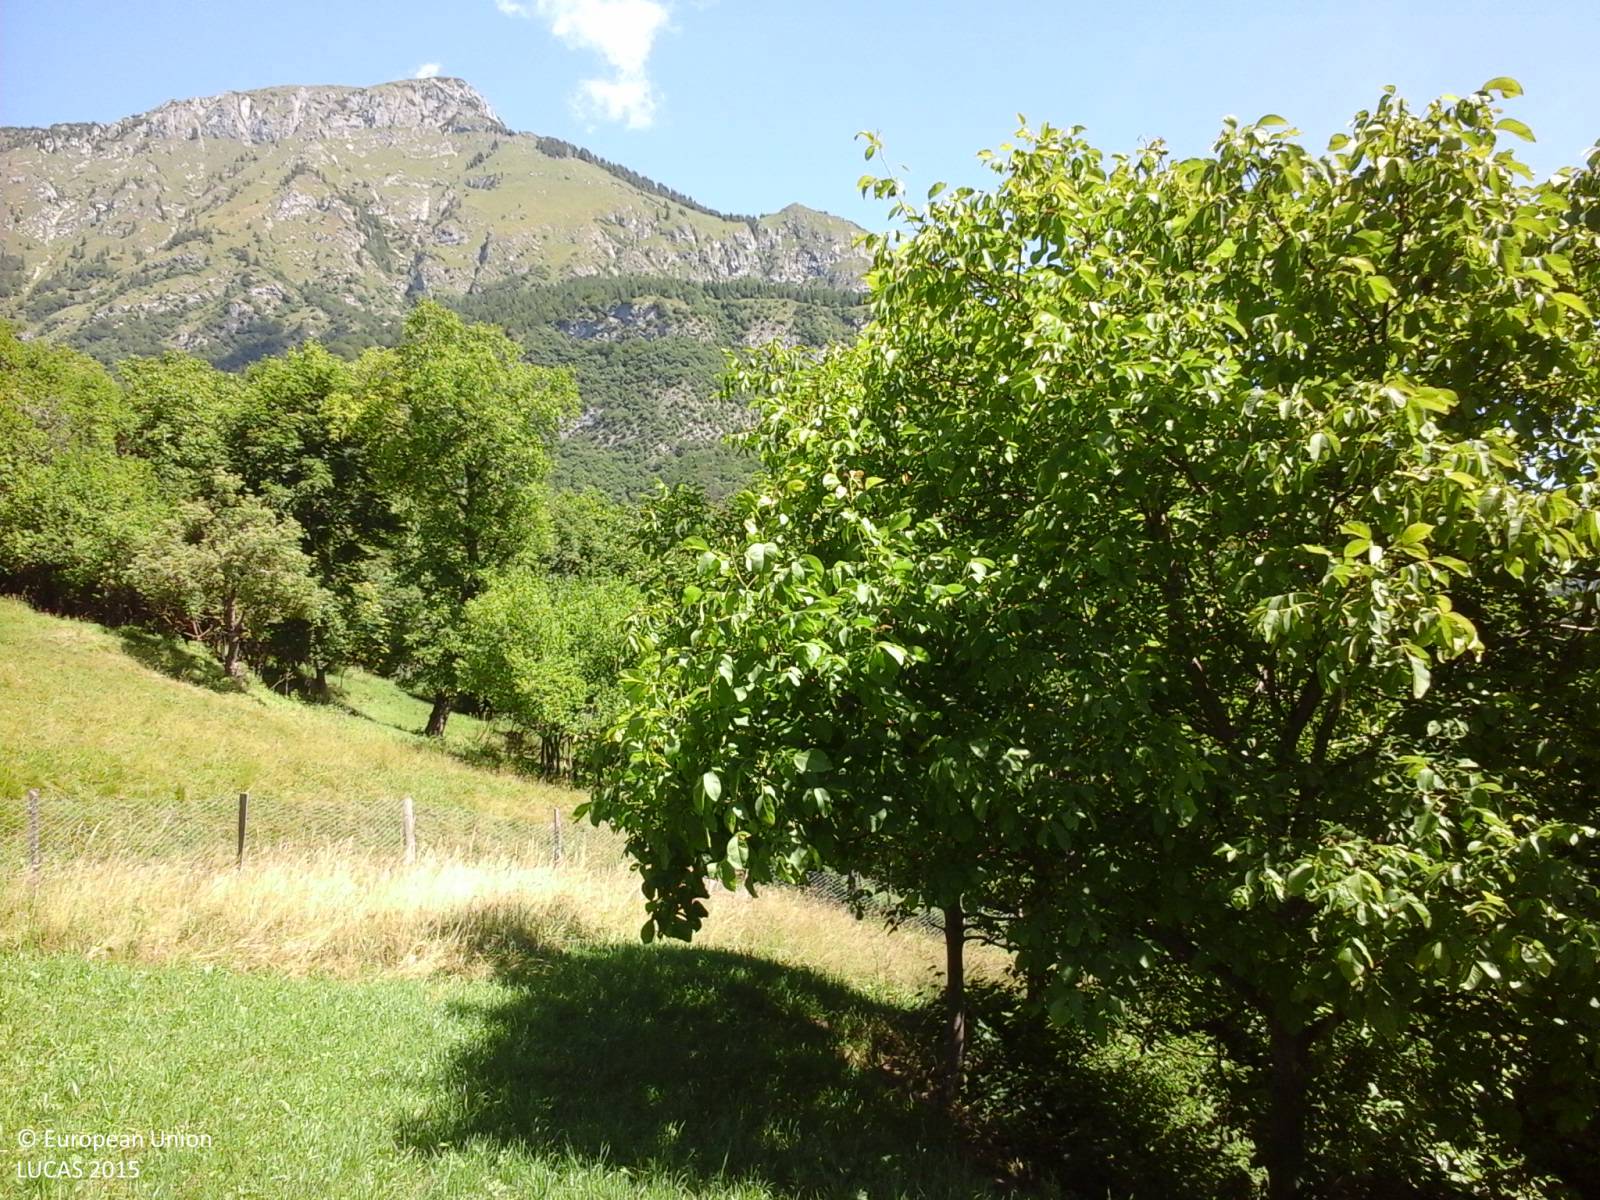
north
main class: Grassland
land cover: Grassland without tree/shrub cover
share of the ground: > 75 %
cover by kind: herbaceous plants 100 %
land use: Agriculture (excluding fallow land and kitchen gardens)
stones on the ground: < 10 %
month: June
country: IT
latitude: 46.4870
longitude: 13.0845
